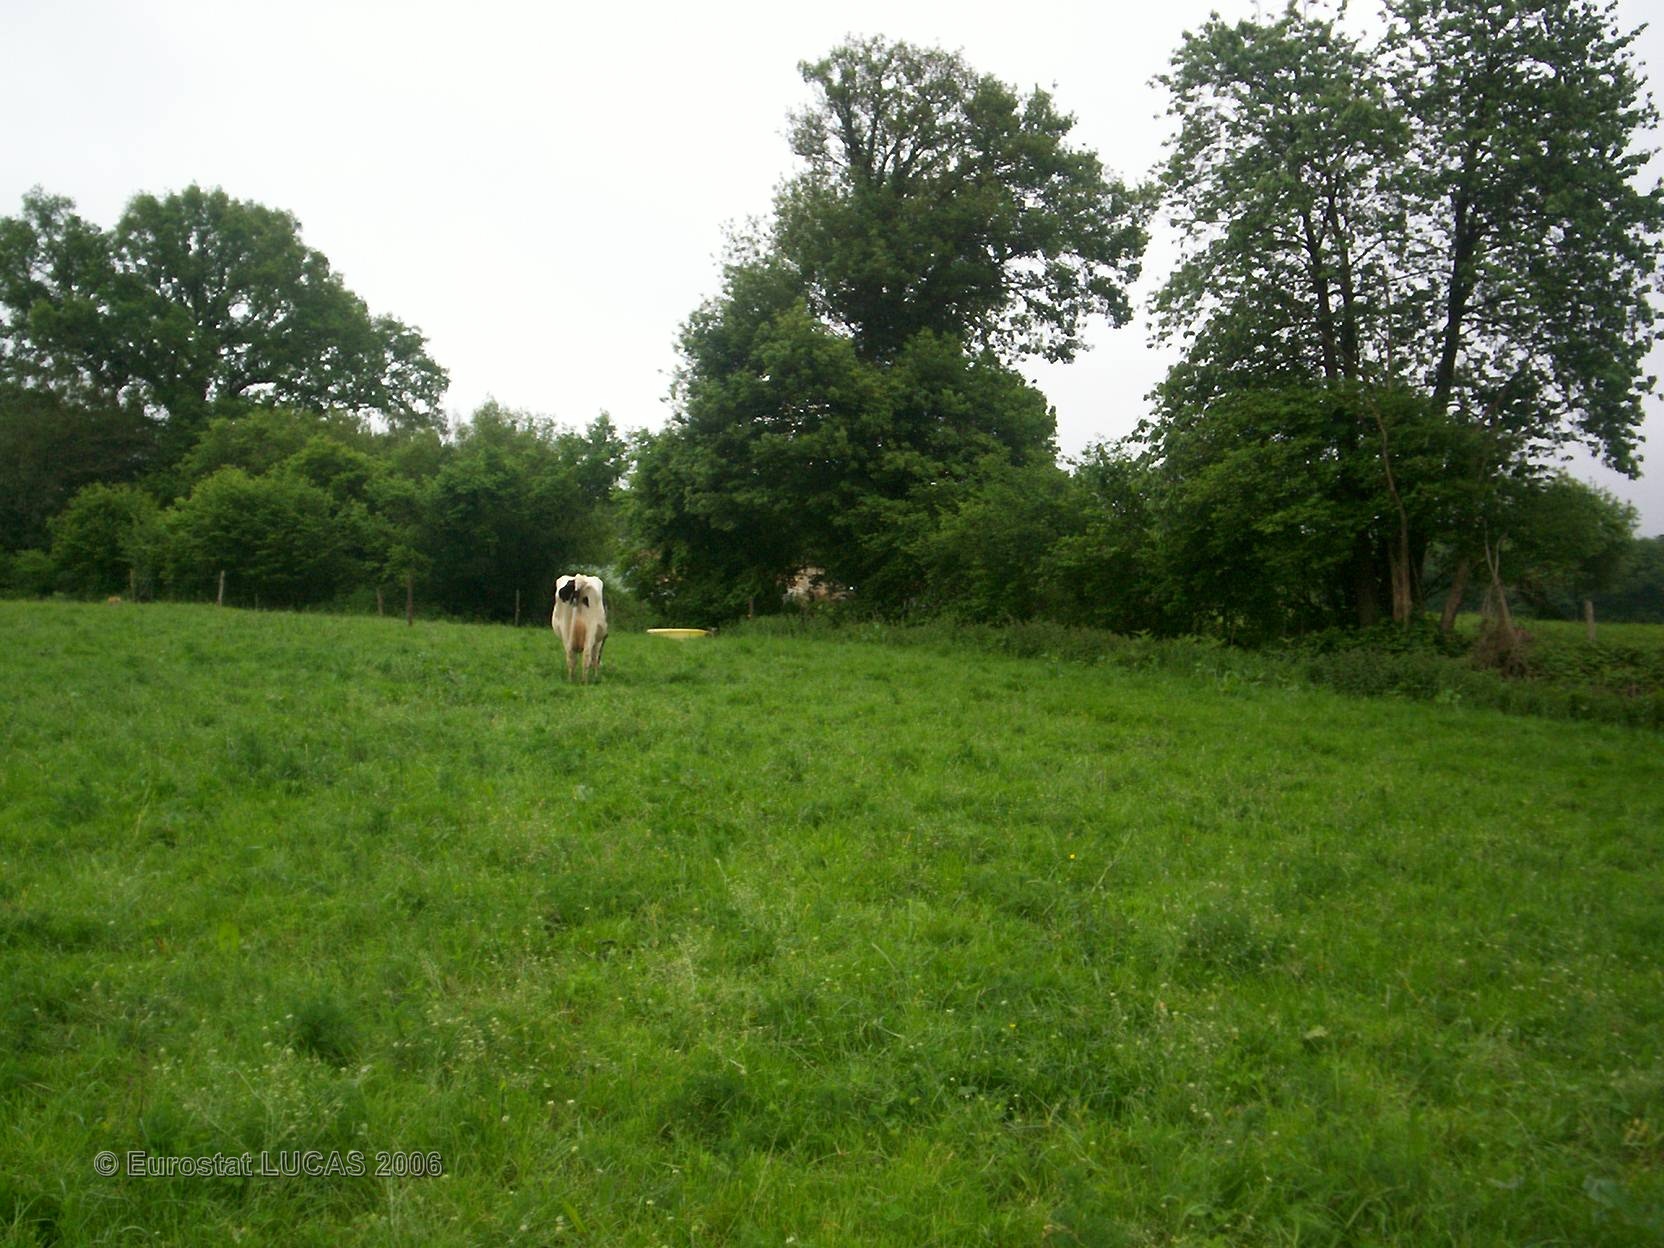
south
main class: Grassland
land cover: Grassland without tree/shrub cover
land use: Agriculture (excluding fallow land and kitchen gardens)
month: May
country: FR
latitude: 48.4300
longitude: 0.3103
